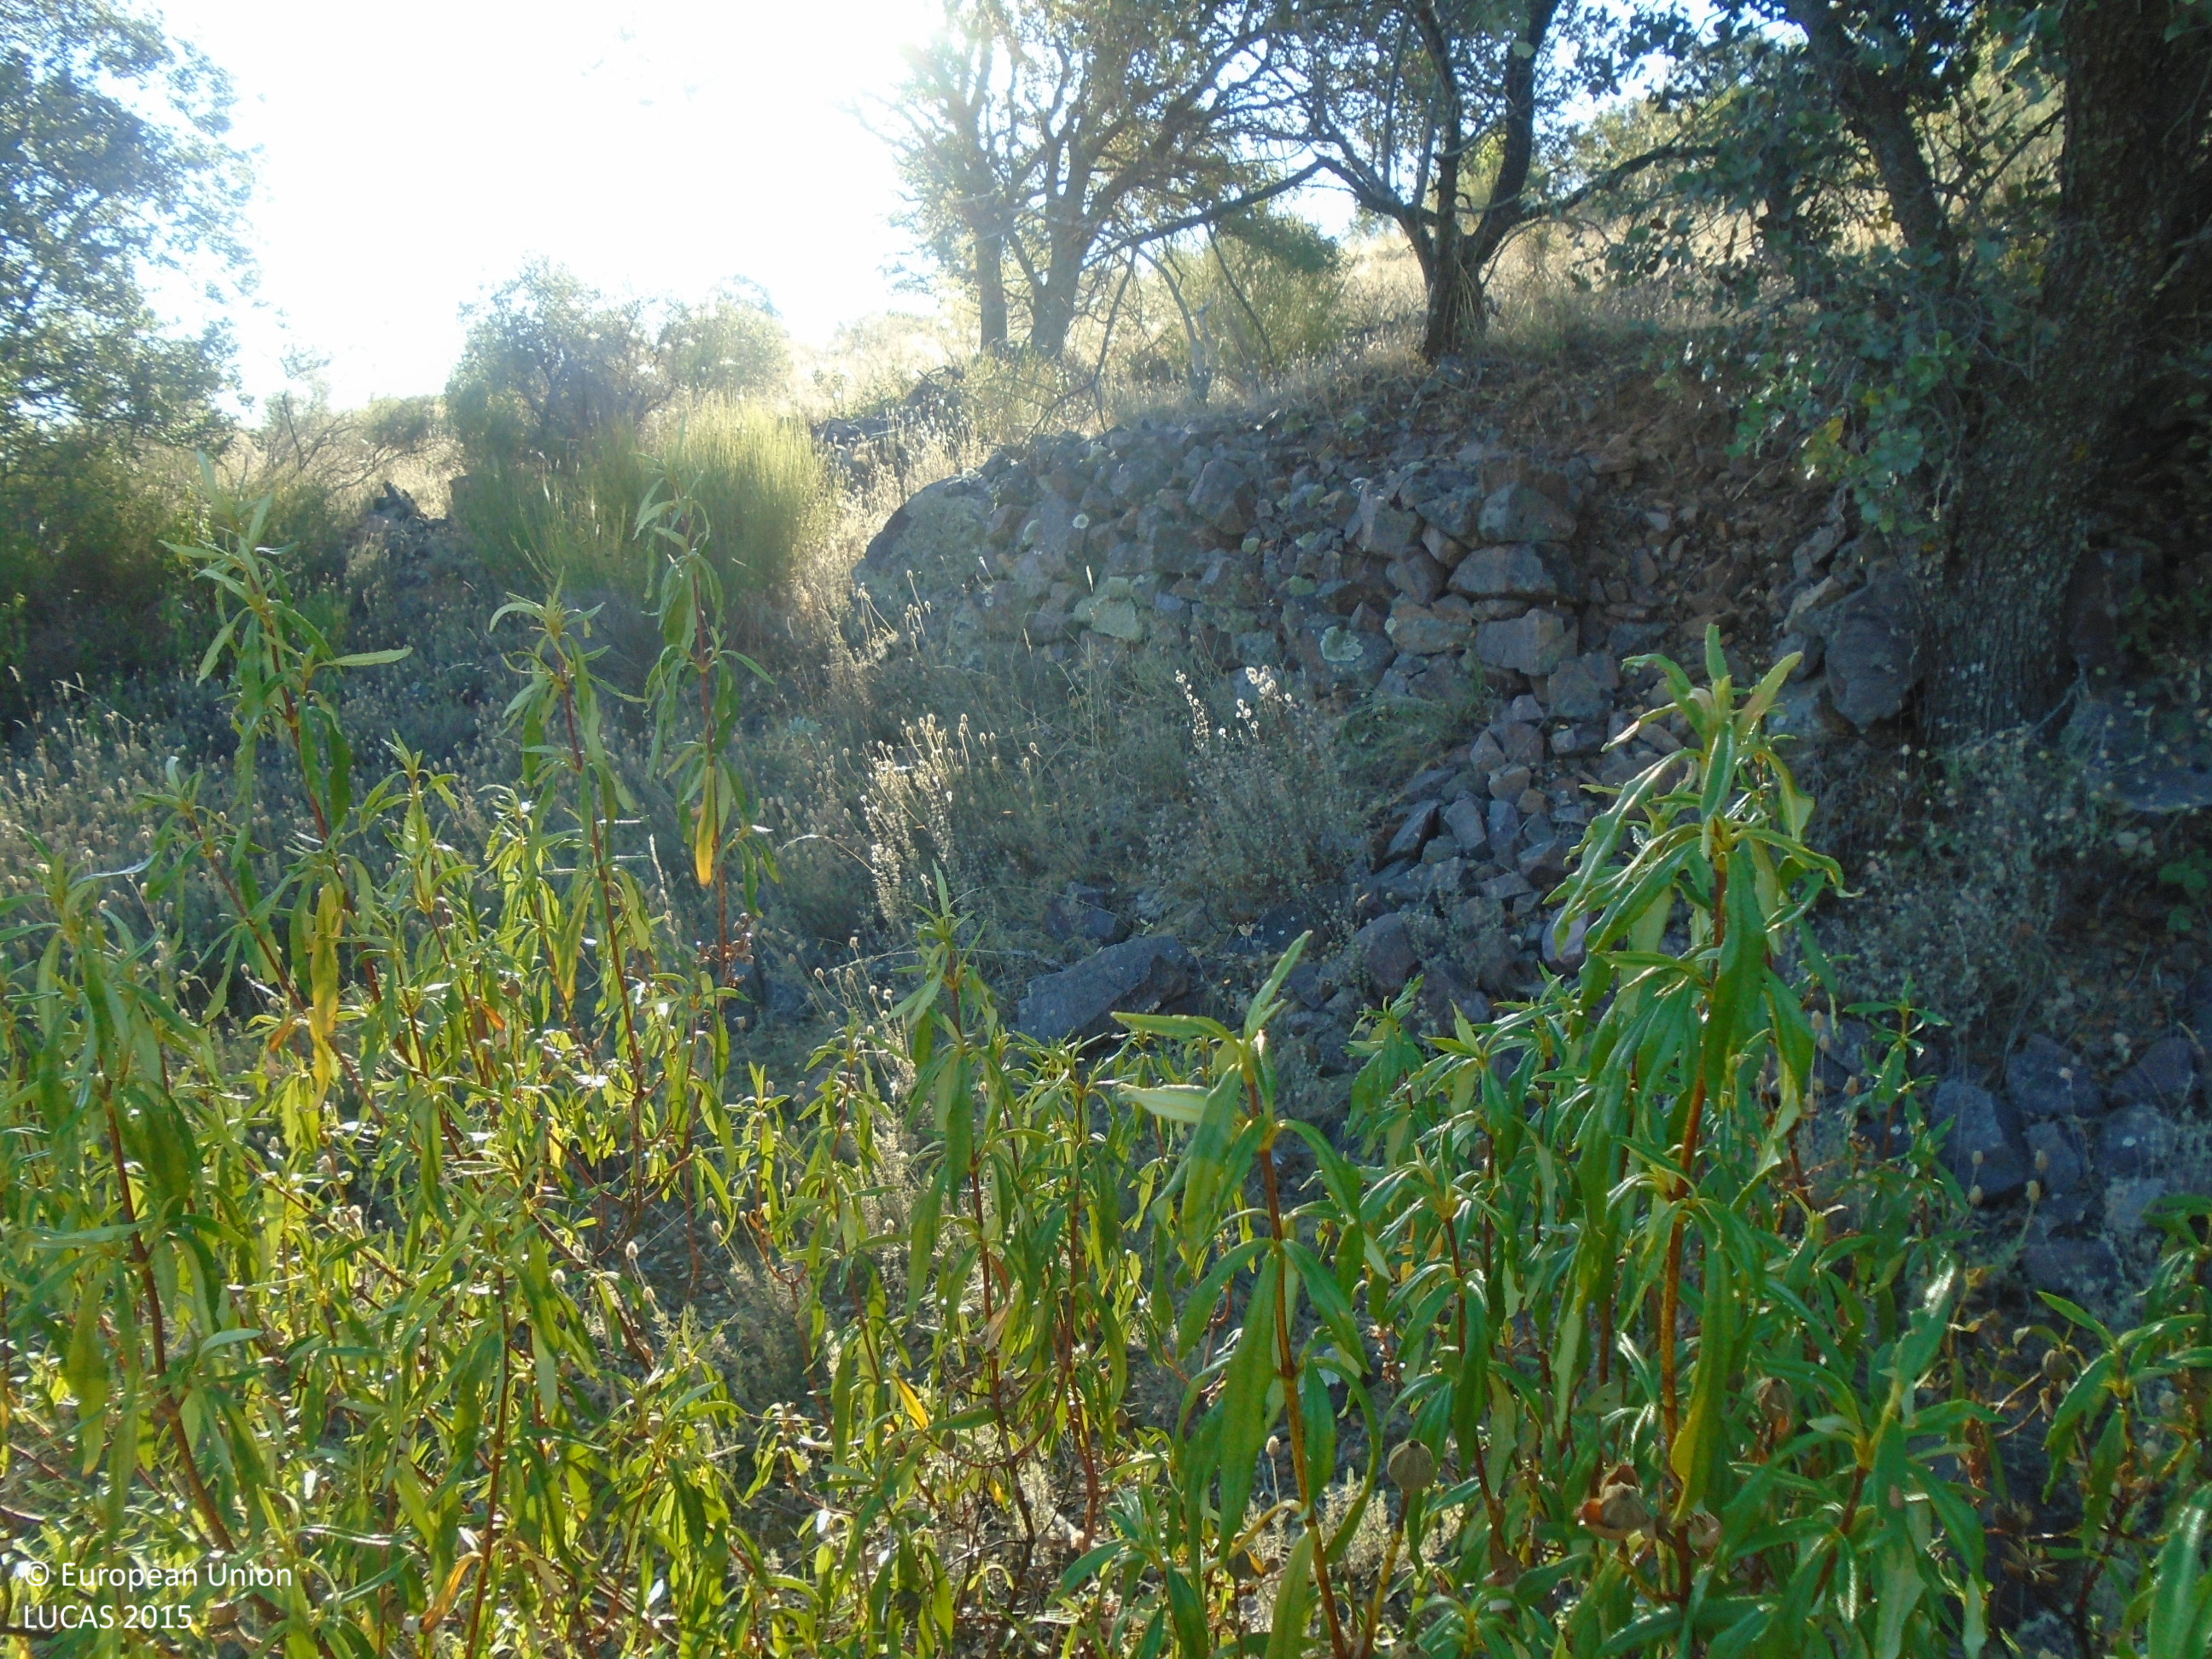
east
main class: Shrubland
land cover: Shrubland with sparse tree cover
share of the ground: > 75 %
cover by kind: shrubs 85 %, herbaceous plants 10 %, broadleaved forest trees 5 %
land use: Semi-natural and natural areas not in use
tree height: < 5 m
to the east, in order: Shrubland with sparse tree cover; Dry stone walls; Shrubland with sparse tree cover; Dry stone walls; Olive groves; Dry stone walls; Shrubland with sparse tree cover
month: July
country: ES
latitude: 39.7003
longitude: -5.0809
